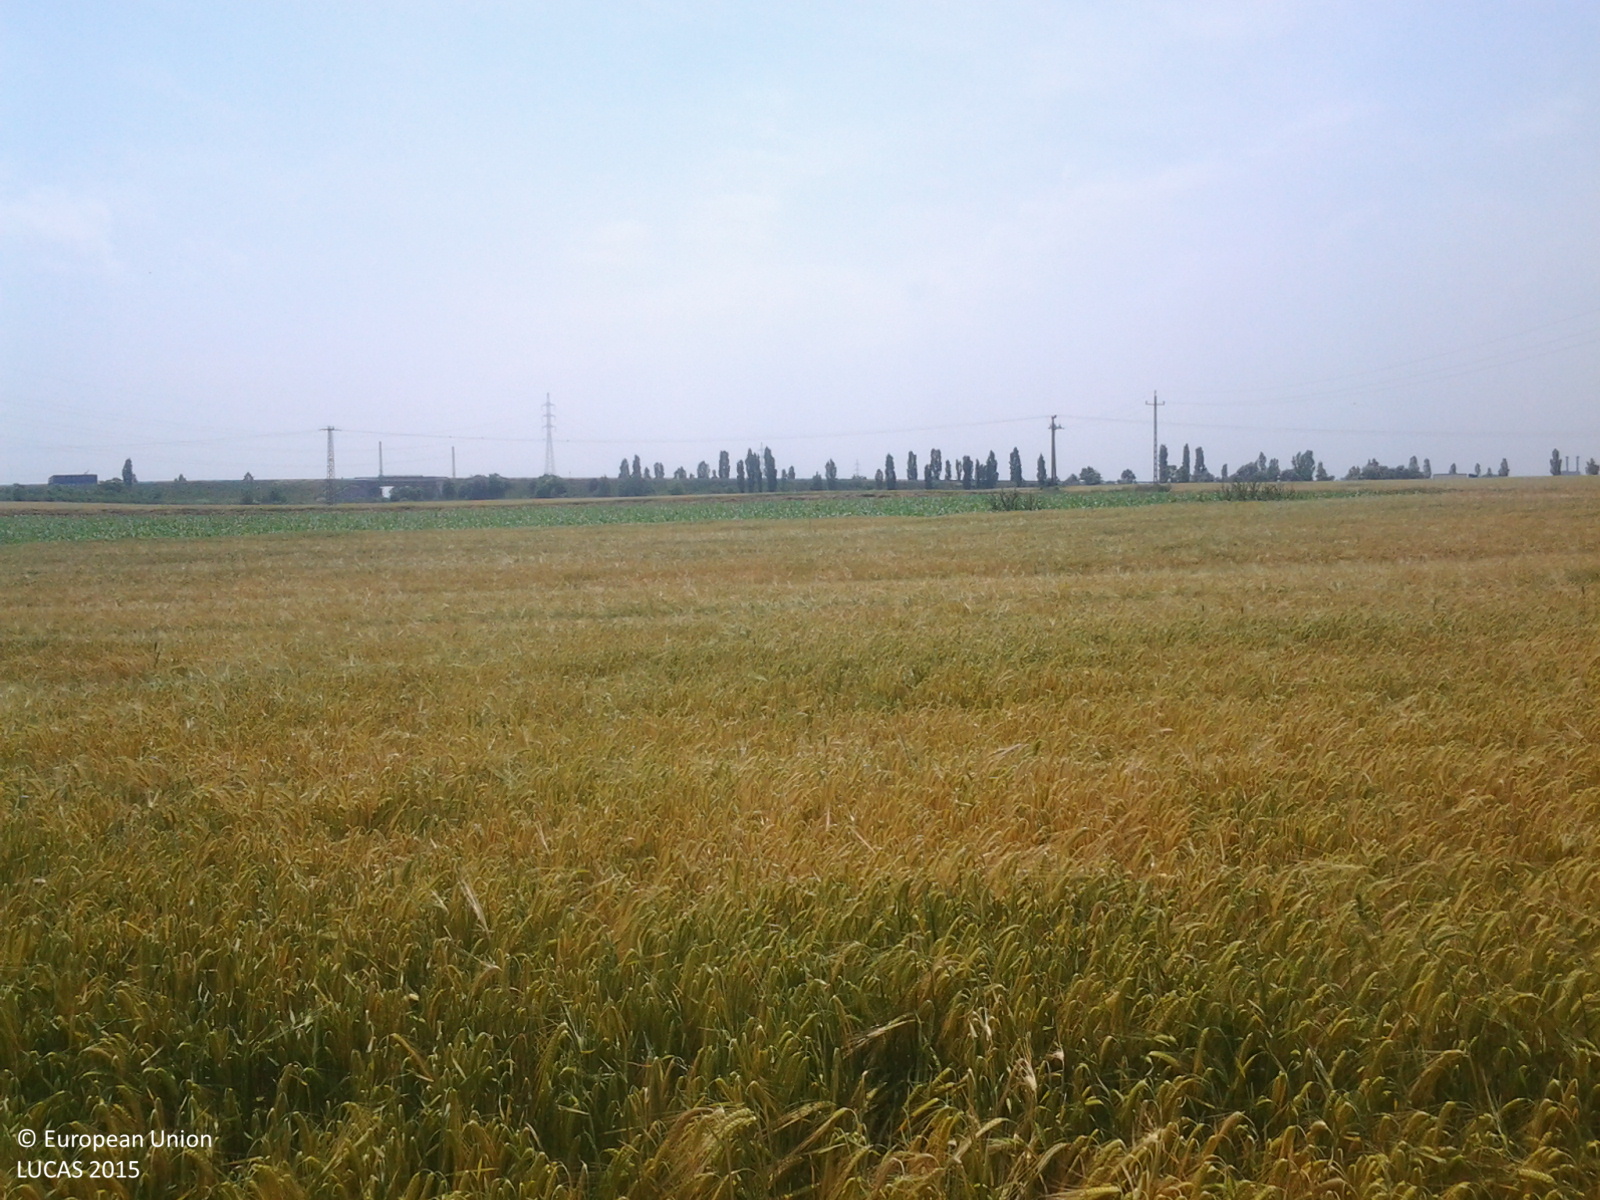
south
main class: Cropland
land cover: Barley
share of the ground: > 75 %
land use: Agriculture (excluding fallow land and kitchen gardens)
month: June
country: HU
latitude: 46.8868
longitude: 19.7192
